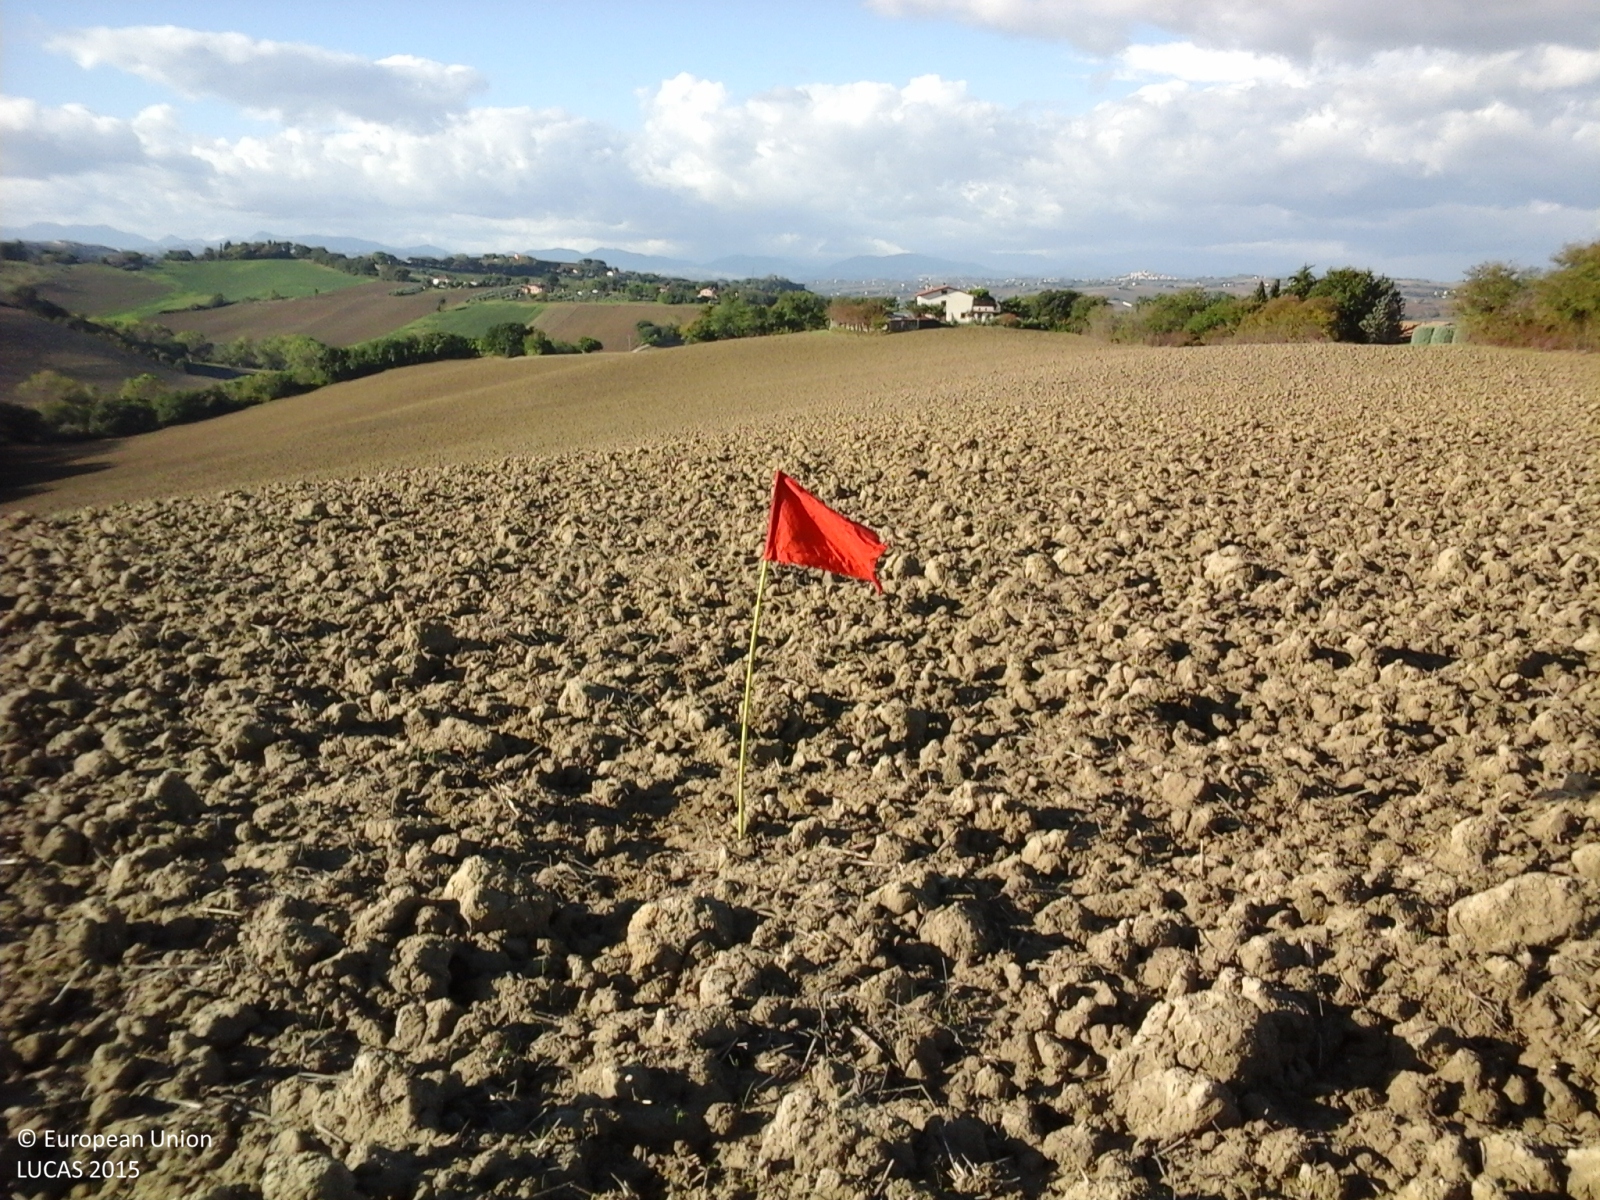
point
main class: Cropland
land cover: Durum wheat
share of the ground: < 10 %
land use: Agriculture (excluding fallow land and kitchen gardens)
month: October
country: IT
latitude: 43.6520
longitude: 13.1788
